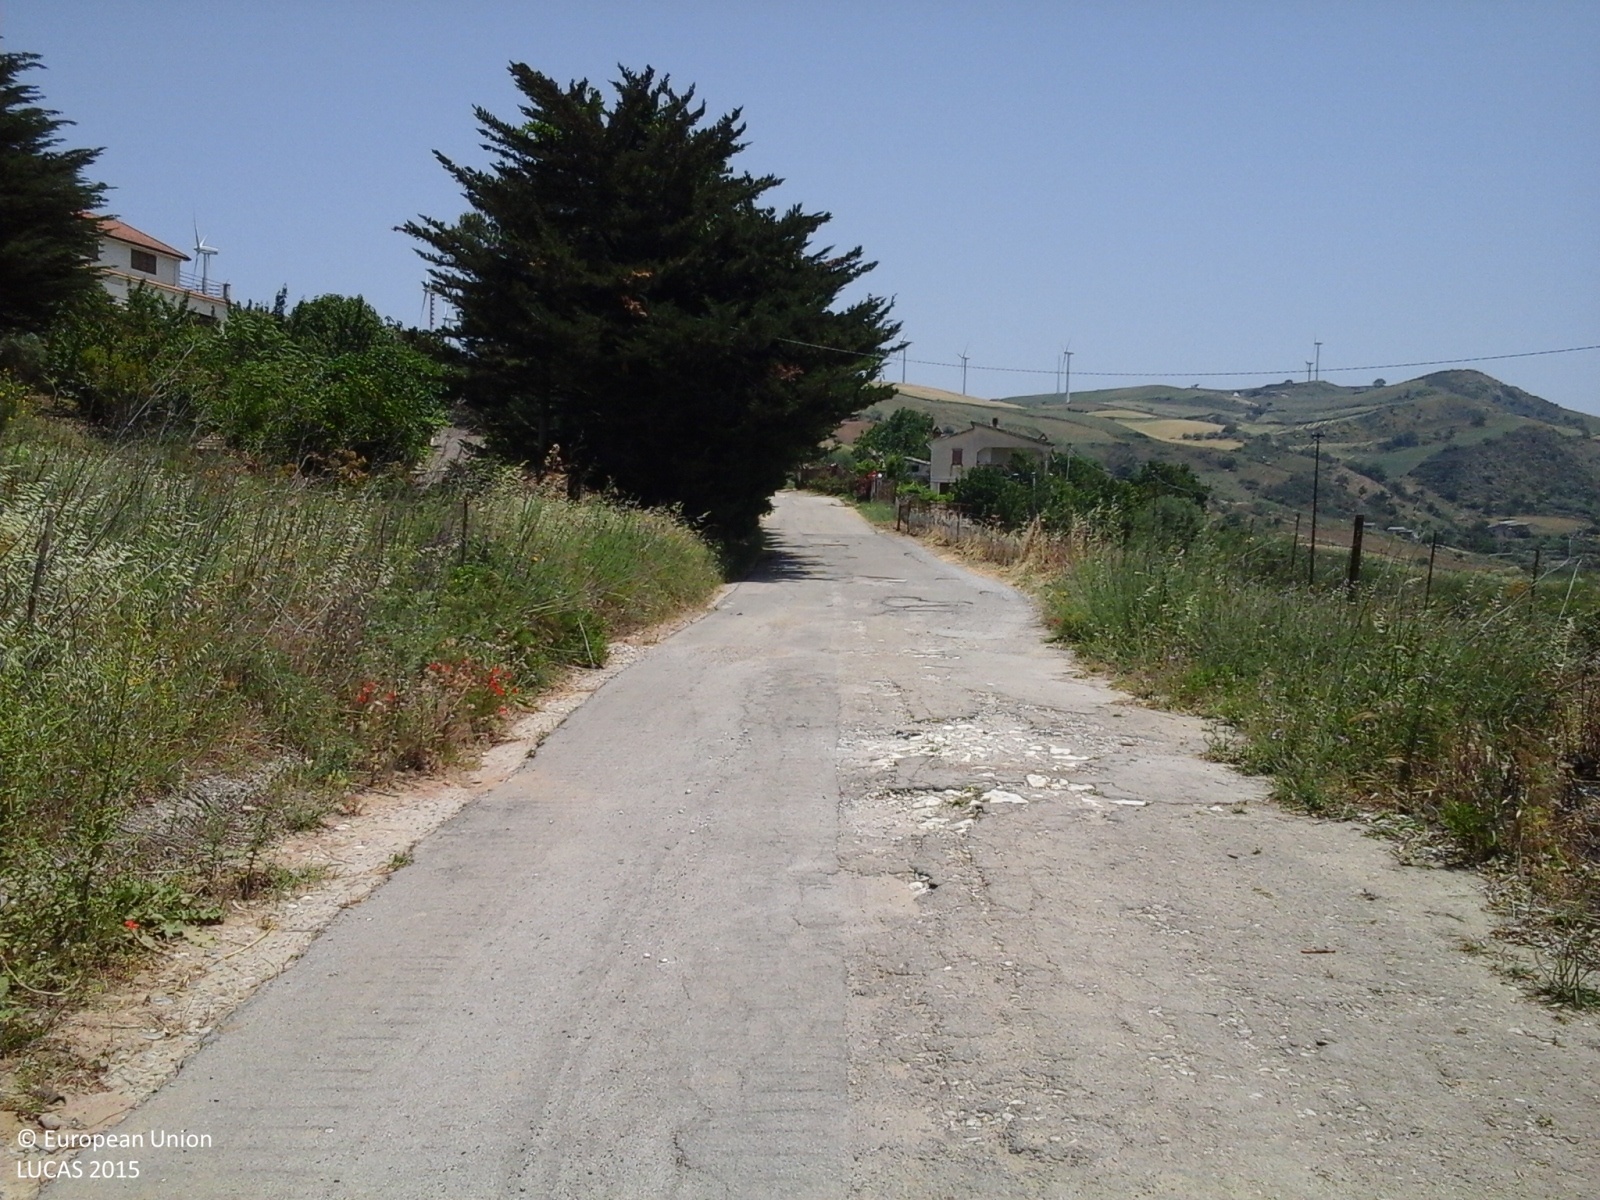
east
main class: Grassland
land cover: Grassland without tree/shrub cover
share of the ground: > 75 %
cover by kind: herbaceous plants 100 %
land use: Agriculture (excluding fallow land and kitchen gardens)
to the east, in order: Grassland without tree/shrub cover; Fences; Grassland with sparse tree/shrub cover; Broadleaved woodland; Fences; Other bare soil
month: June
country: IT
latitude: 37.7643
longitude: 13.7528
